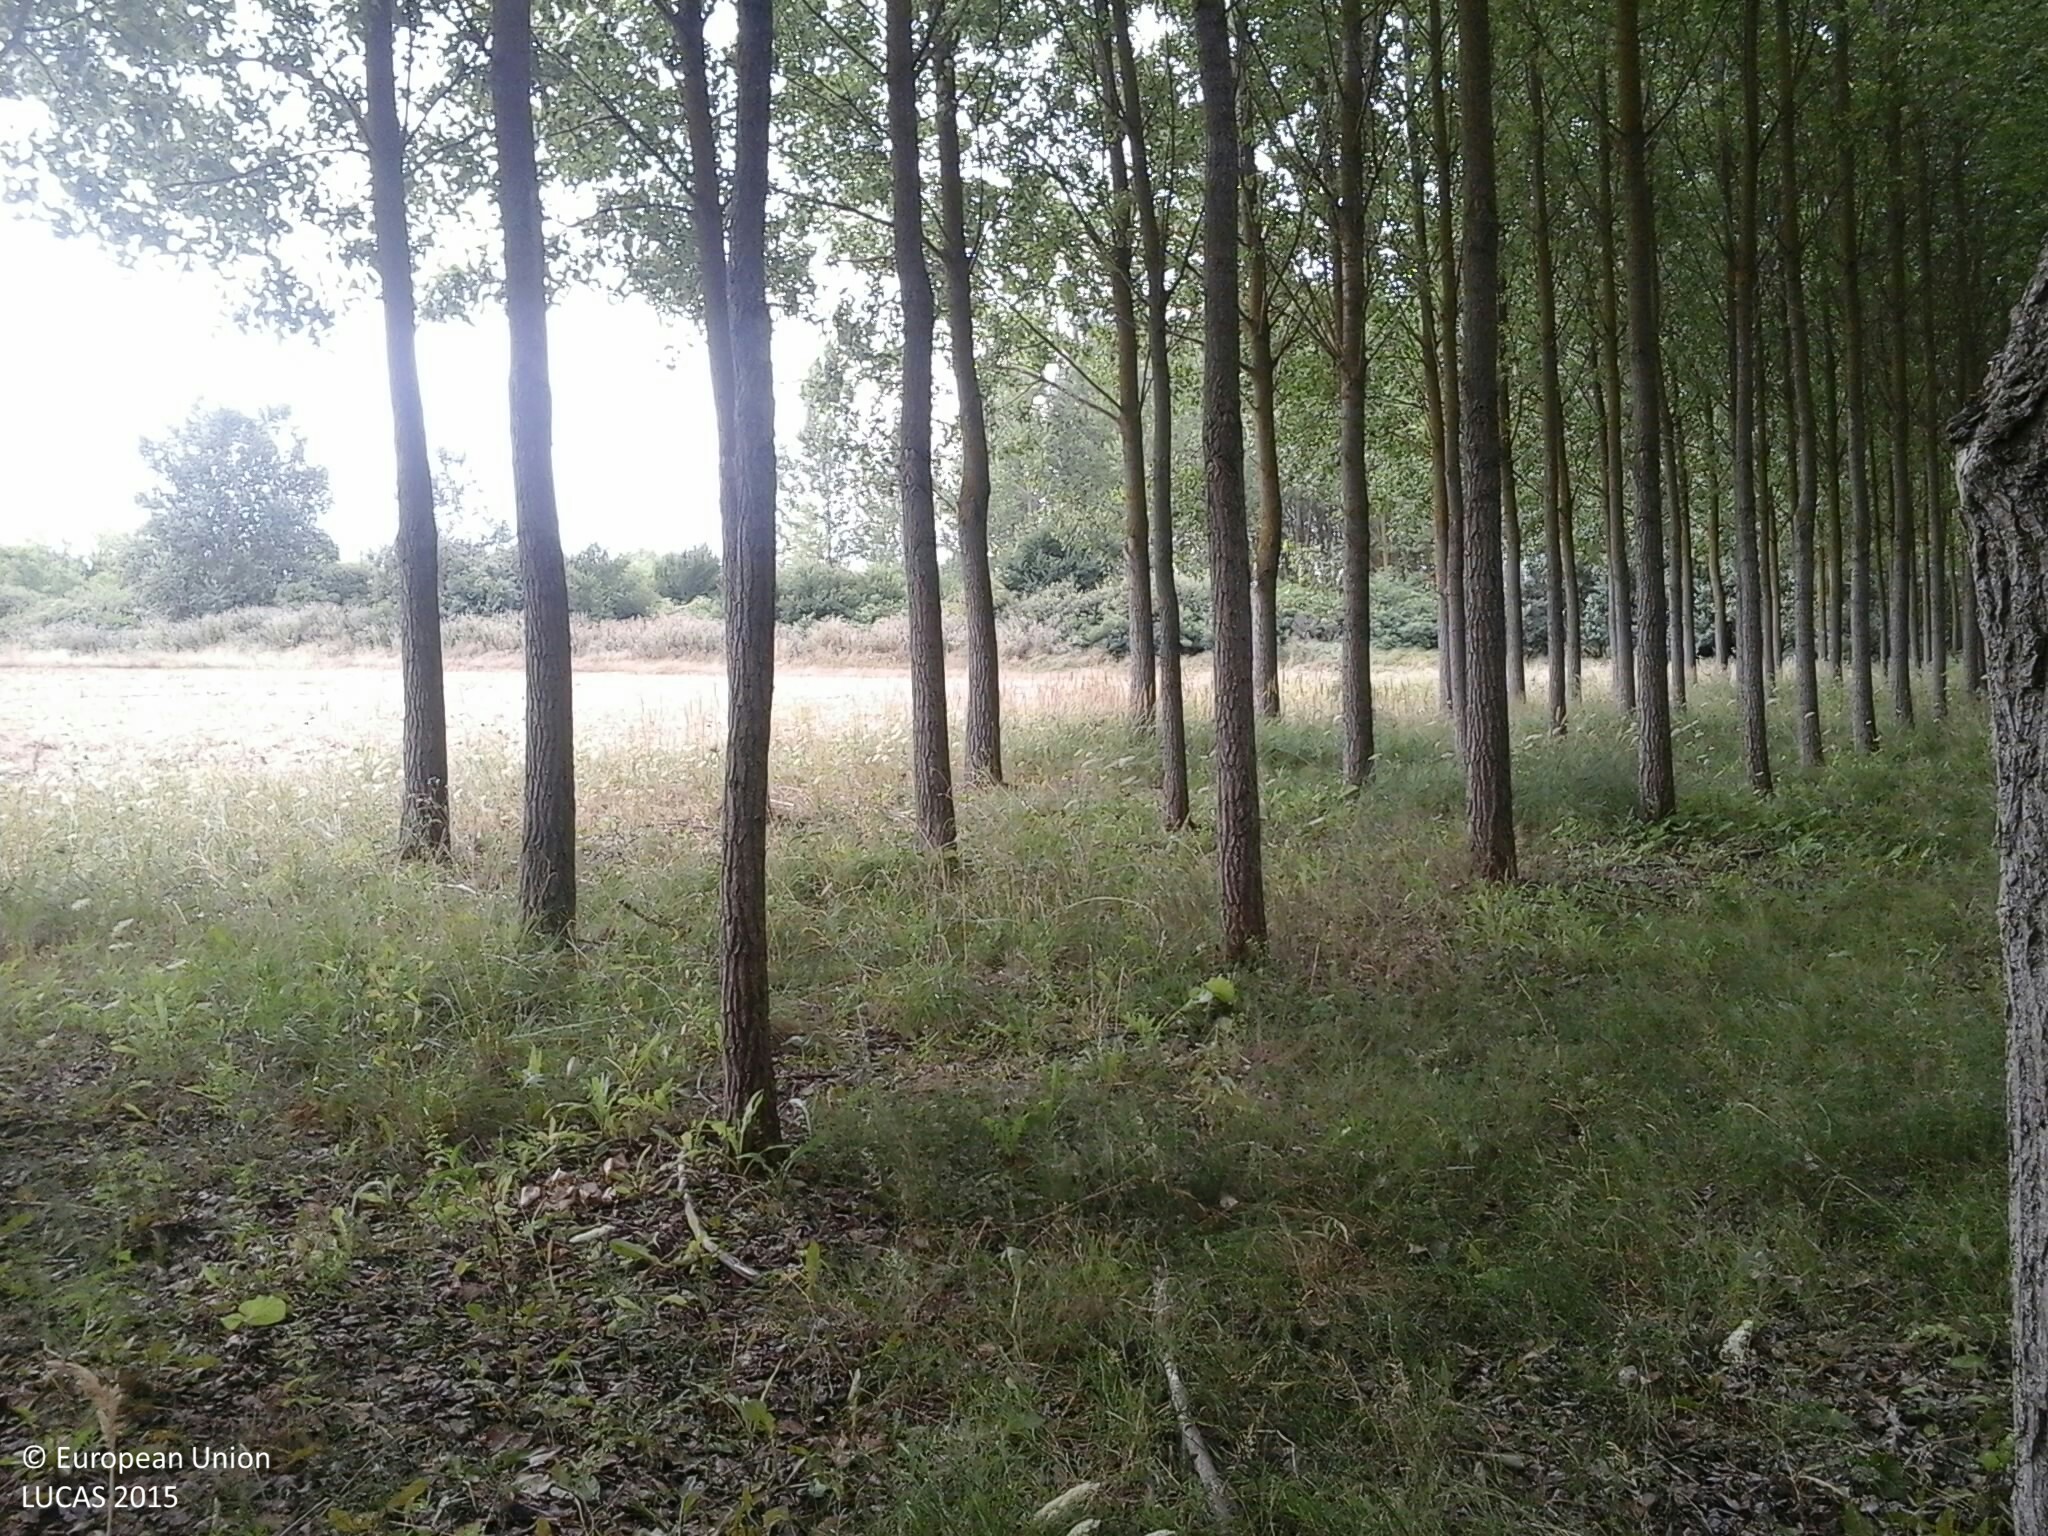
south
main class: Woodland
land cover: Broadleaved woodland
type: non-riverine alder, birch or aspen forest
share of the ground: 50 - 75 %
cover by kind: broadleaved forest trees 80 %, herbaceous plants 20 %
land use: Forestry
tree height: > 5 m
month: July
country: HU
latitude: 47.7203
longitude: 20.8742
